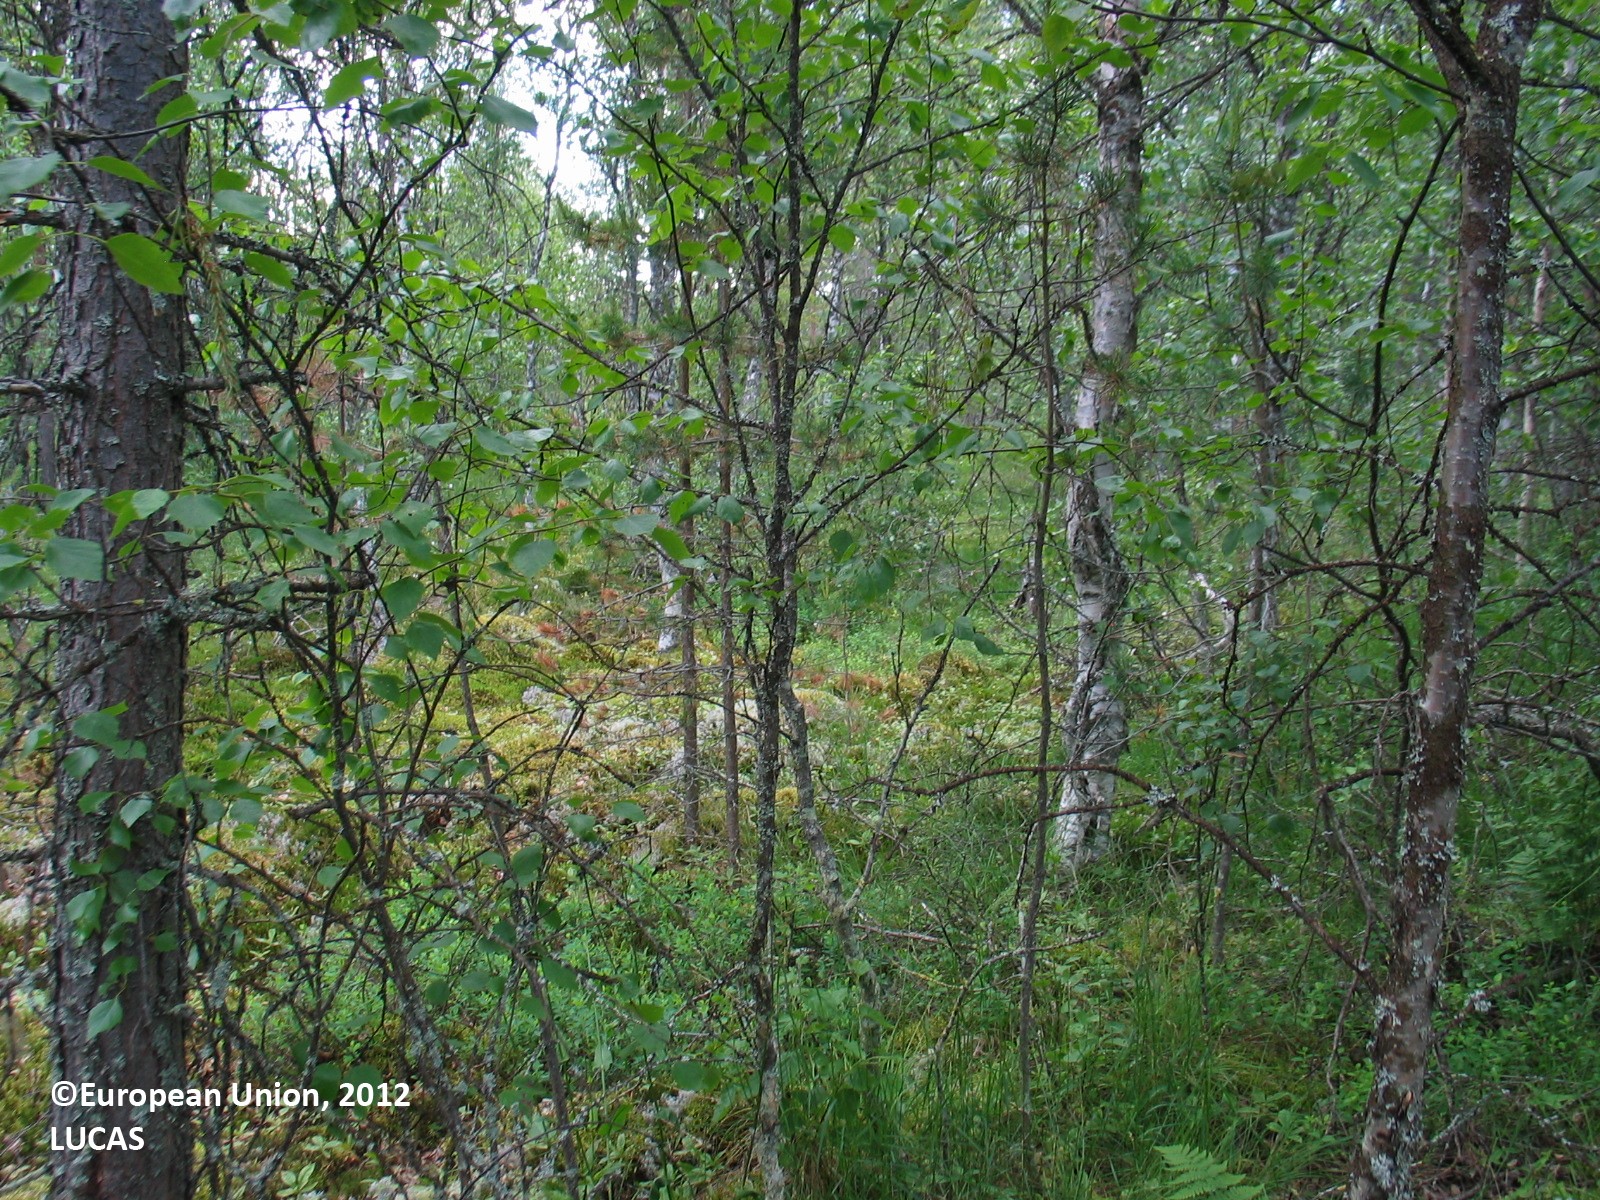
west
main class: Woodland
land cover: Other mixed woodland
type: boreal forest
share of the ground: 25 - 50 %
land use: Semi-natural and natural areas not in use
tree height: > 5 m
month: July
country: FI
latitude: 64.5294
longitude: 26.4736
